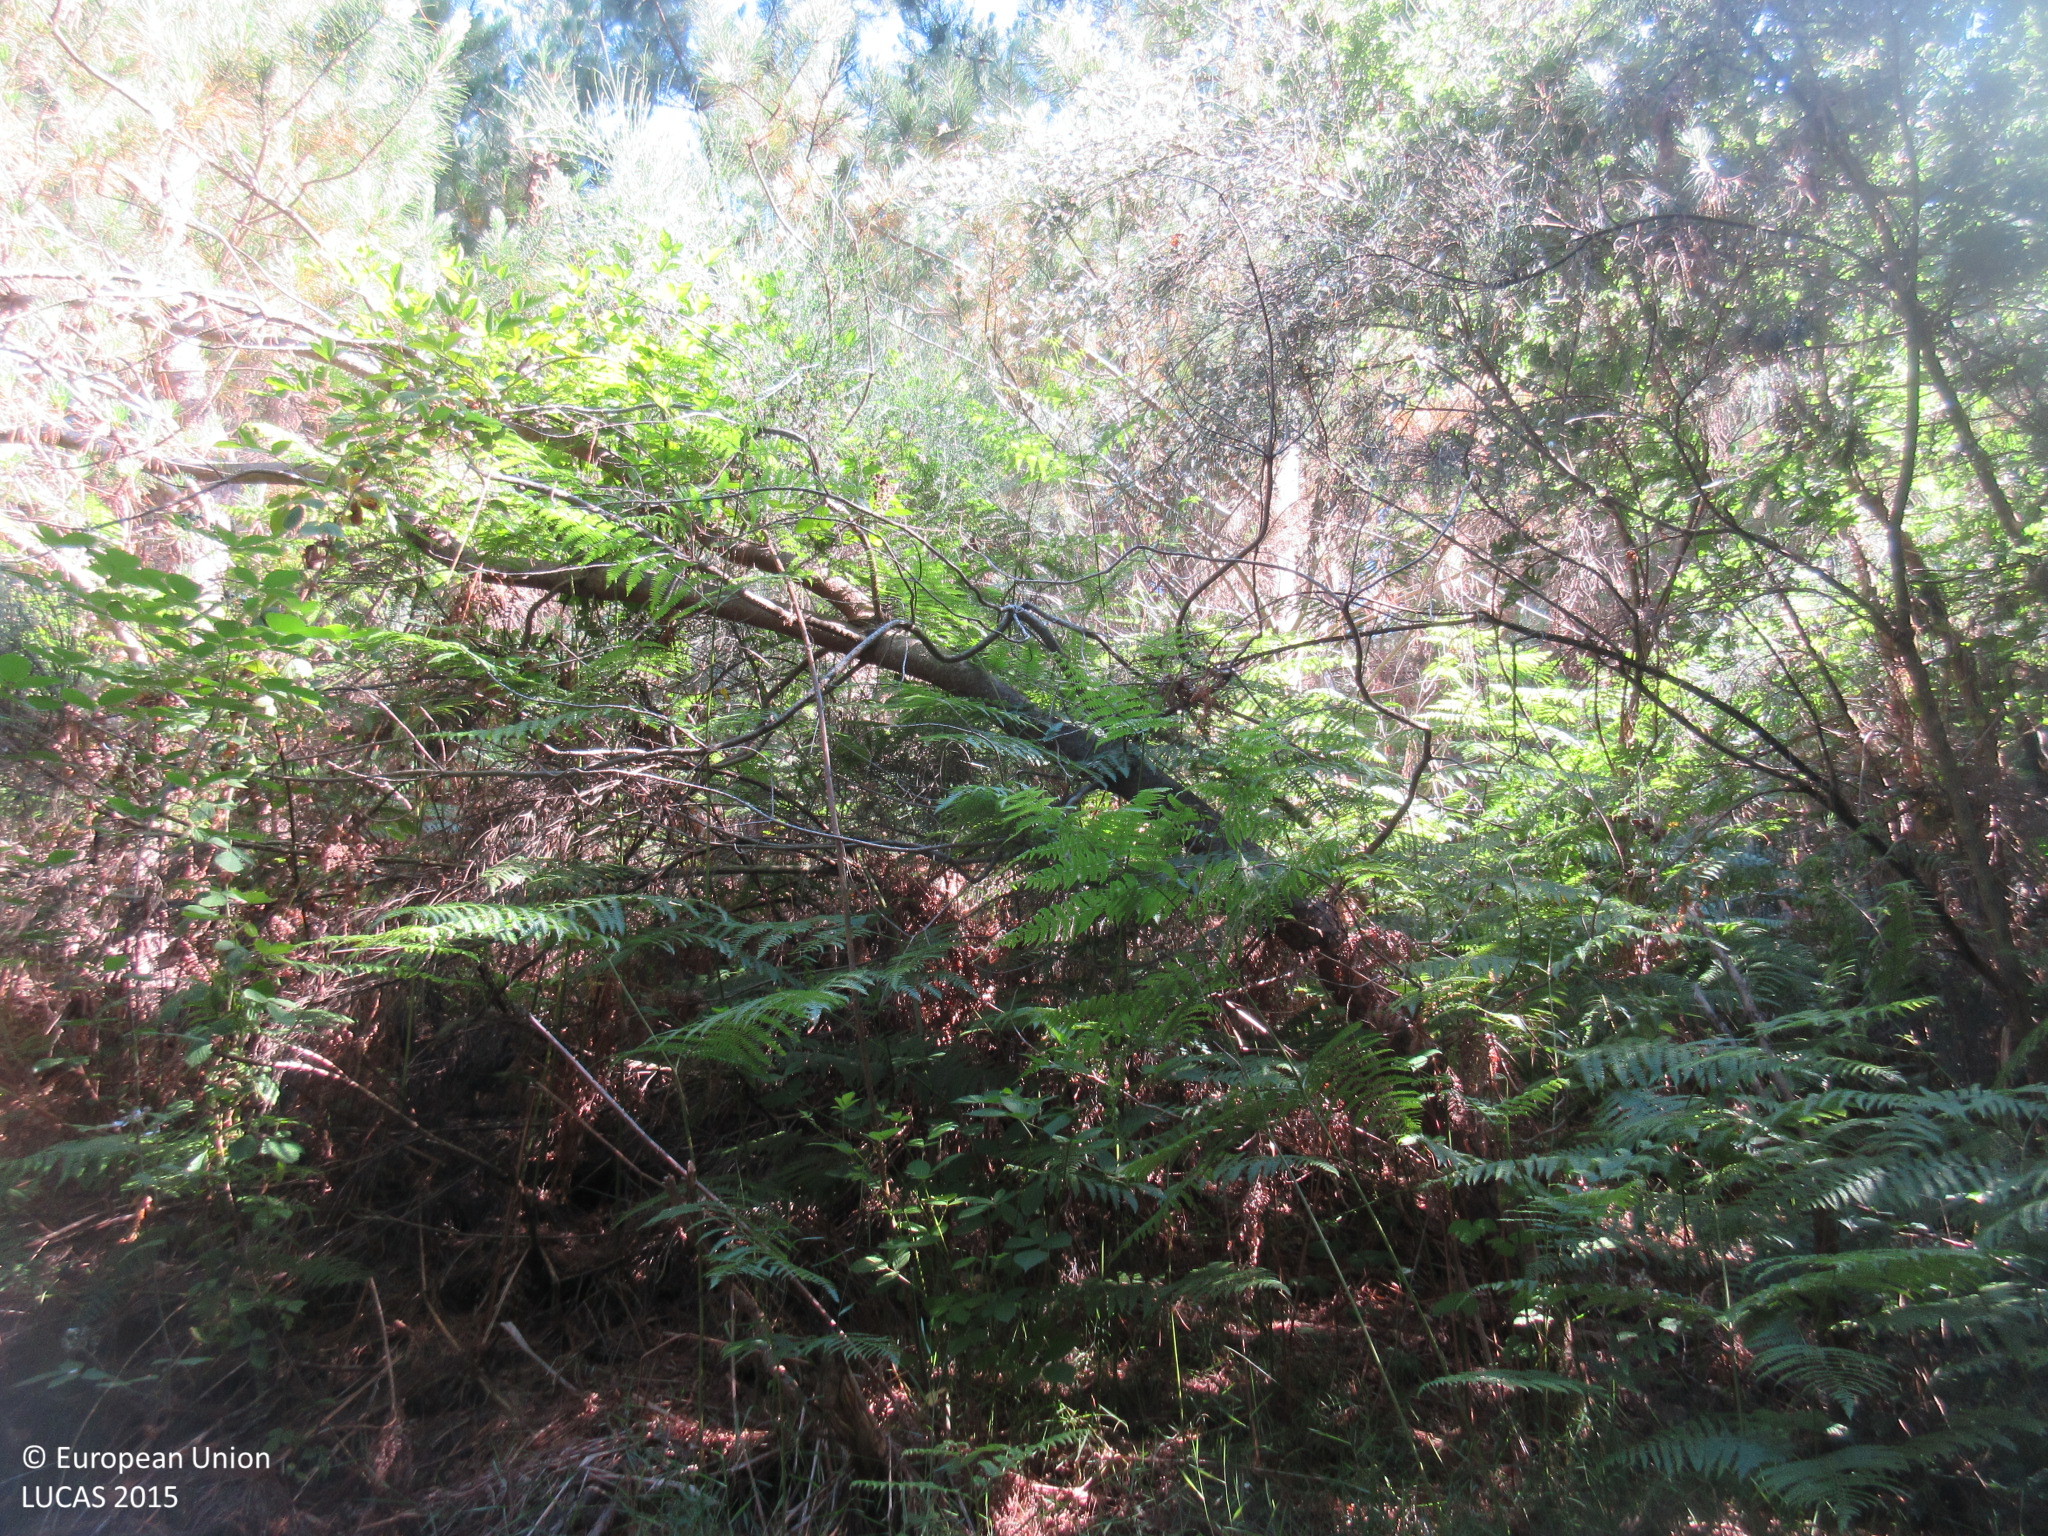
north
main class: Woodland
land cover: Pine dominated mixed woodland
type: hemiboreal forest and nemoral coniferous forest and mixed broadleaved-coniferous forest
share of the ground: > 75 %
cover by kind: coniferous forest trees 55 %, shrubs 25 %, broadleaved forest trees 20 %
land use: Forestry
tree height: > 5 m
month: June
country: ES
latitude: 42.8853
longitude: -6.9689
